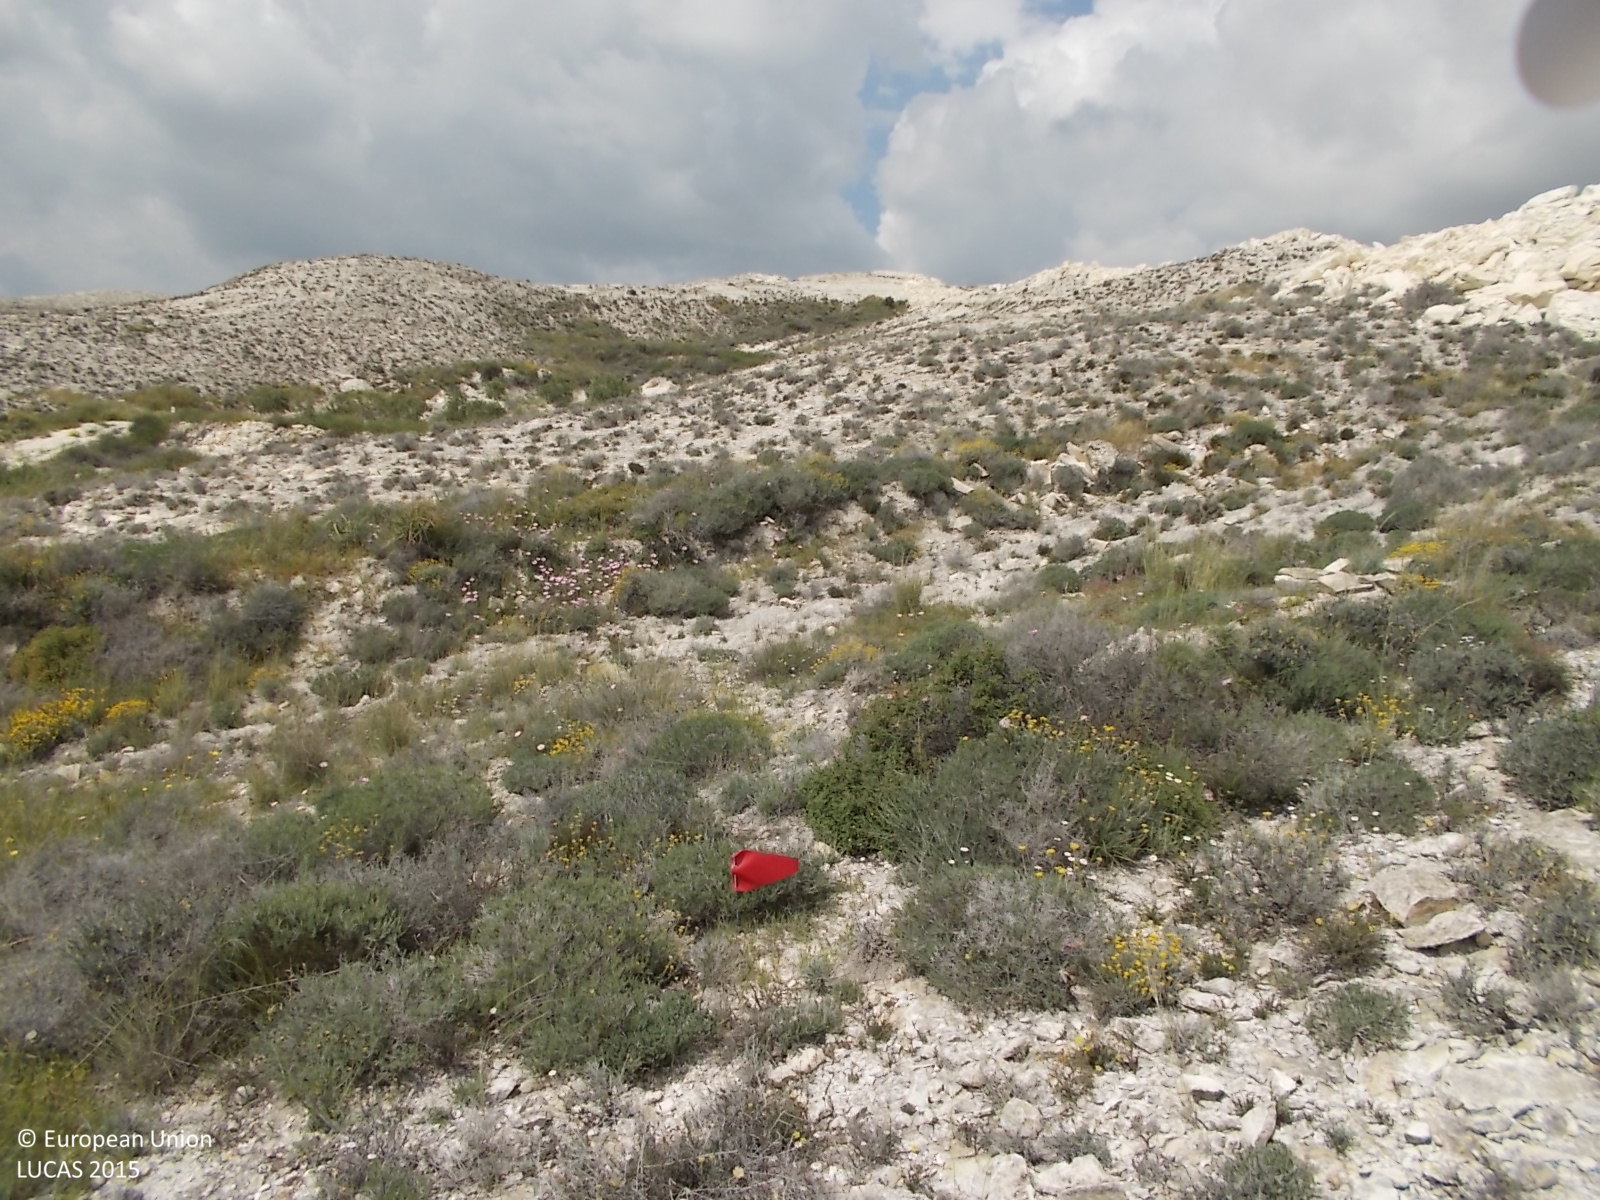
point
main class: Shrubland
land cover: Shrubland without tree cover
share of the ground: 25 - 50 %
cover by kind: shrubs 50 %, unconsolidated bare surface 50 %
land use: Semi-natural and natural areas not in use
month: April
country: CY
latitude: 34.9861
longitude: 33.5629
